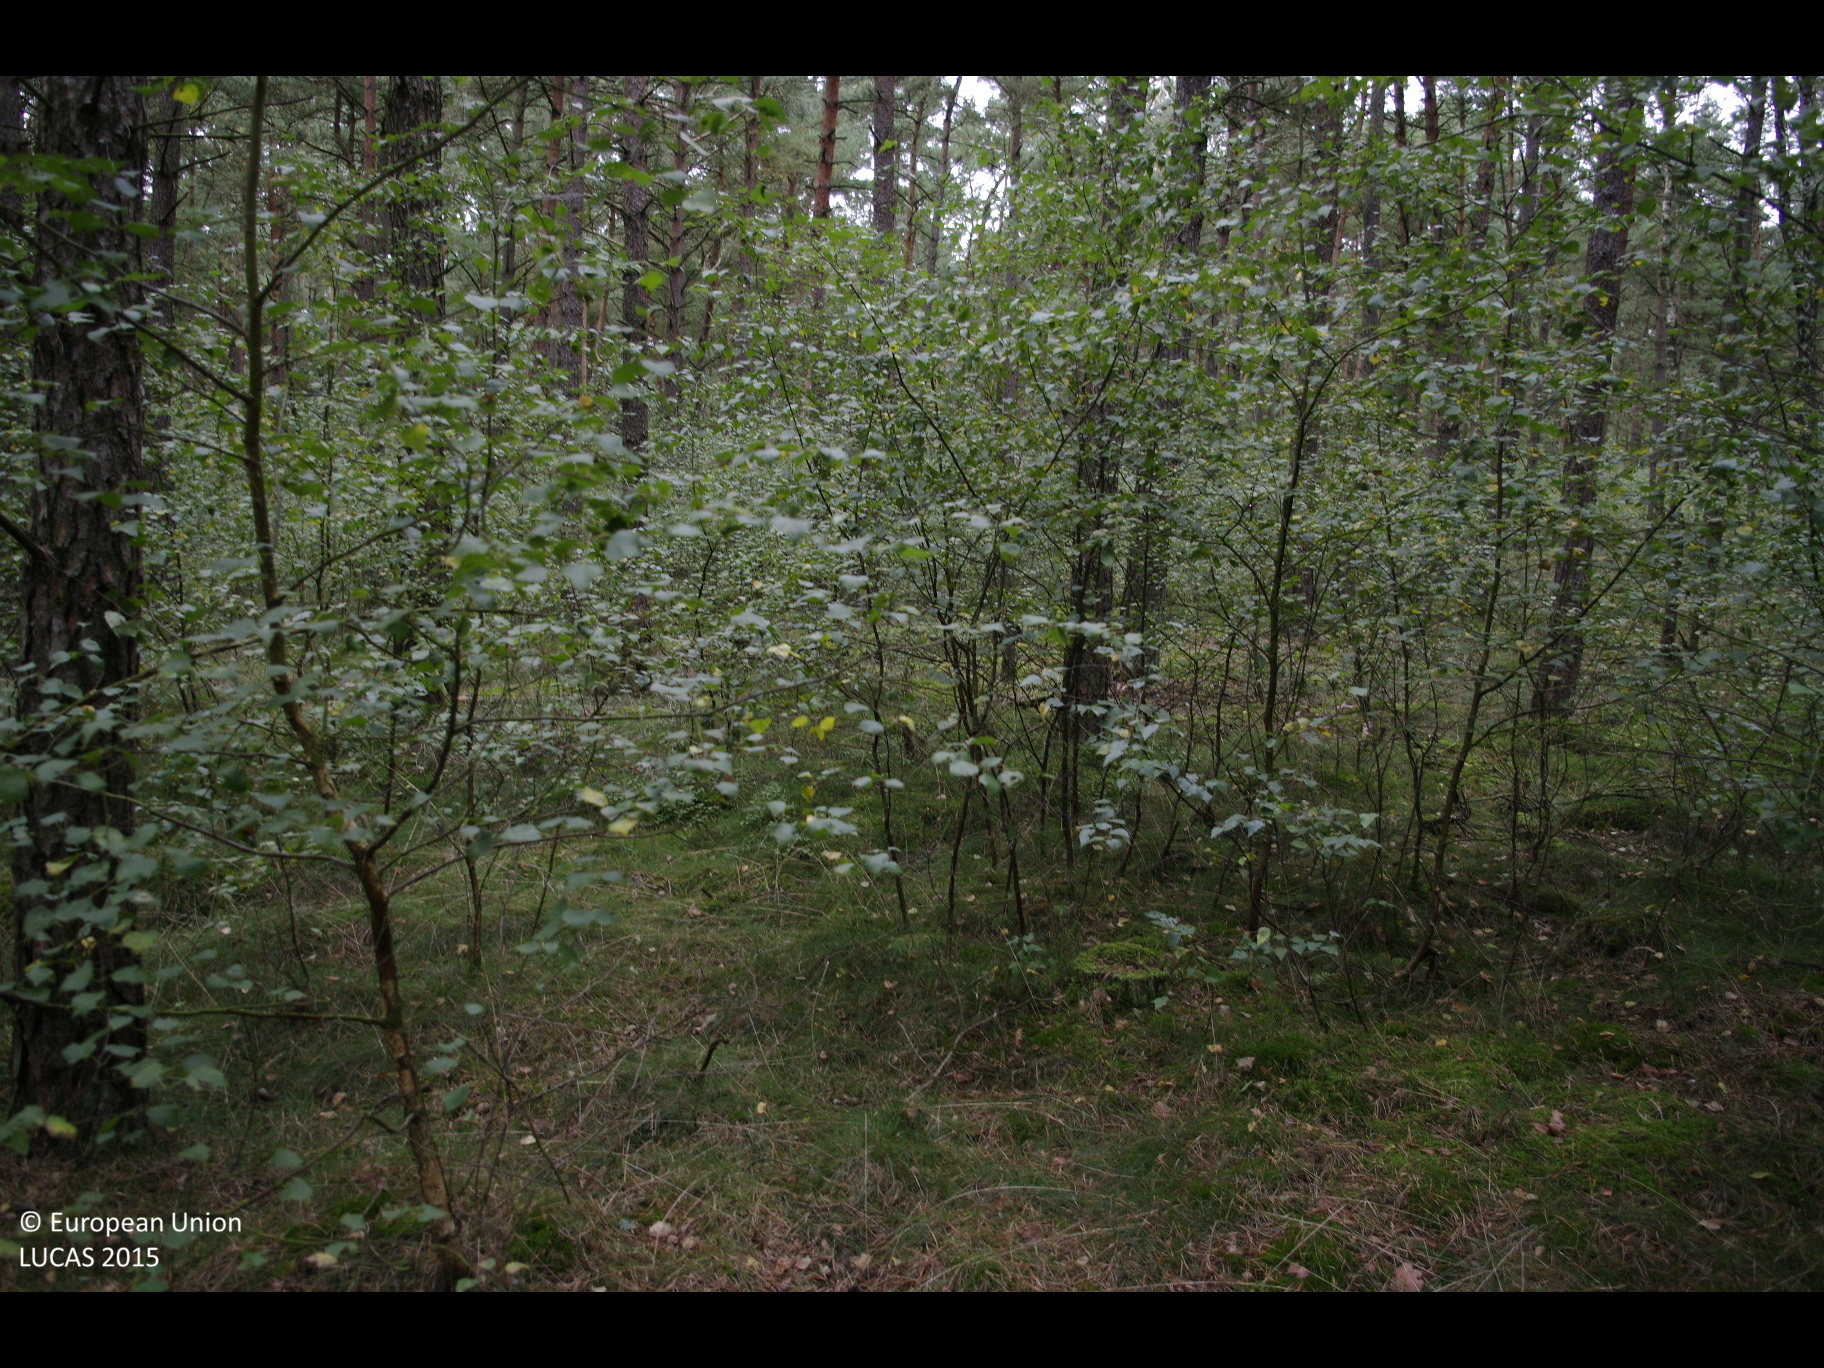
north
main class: Woodland
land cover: Pine dominated mixed woodland
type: hemiboreal forest and nemoral coniferous forest and mixed broadleaved-coniferous forest
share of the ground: 50 - 75 %
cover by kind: coniferous forest trees 40 %, broadleaved forest trees 30 %, herbaceous plants 30 %
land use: Forestry
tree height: > 5 m
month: September
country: DE
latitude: 53.0424
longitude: 9.8658
